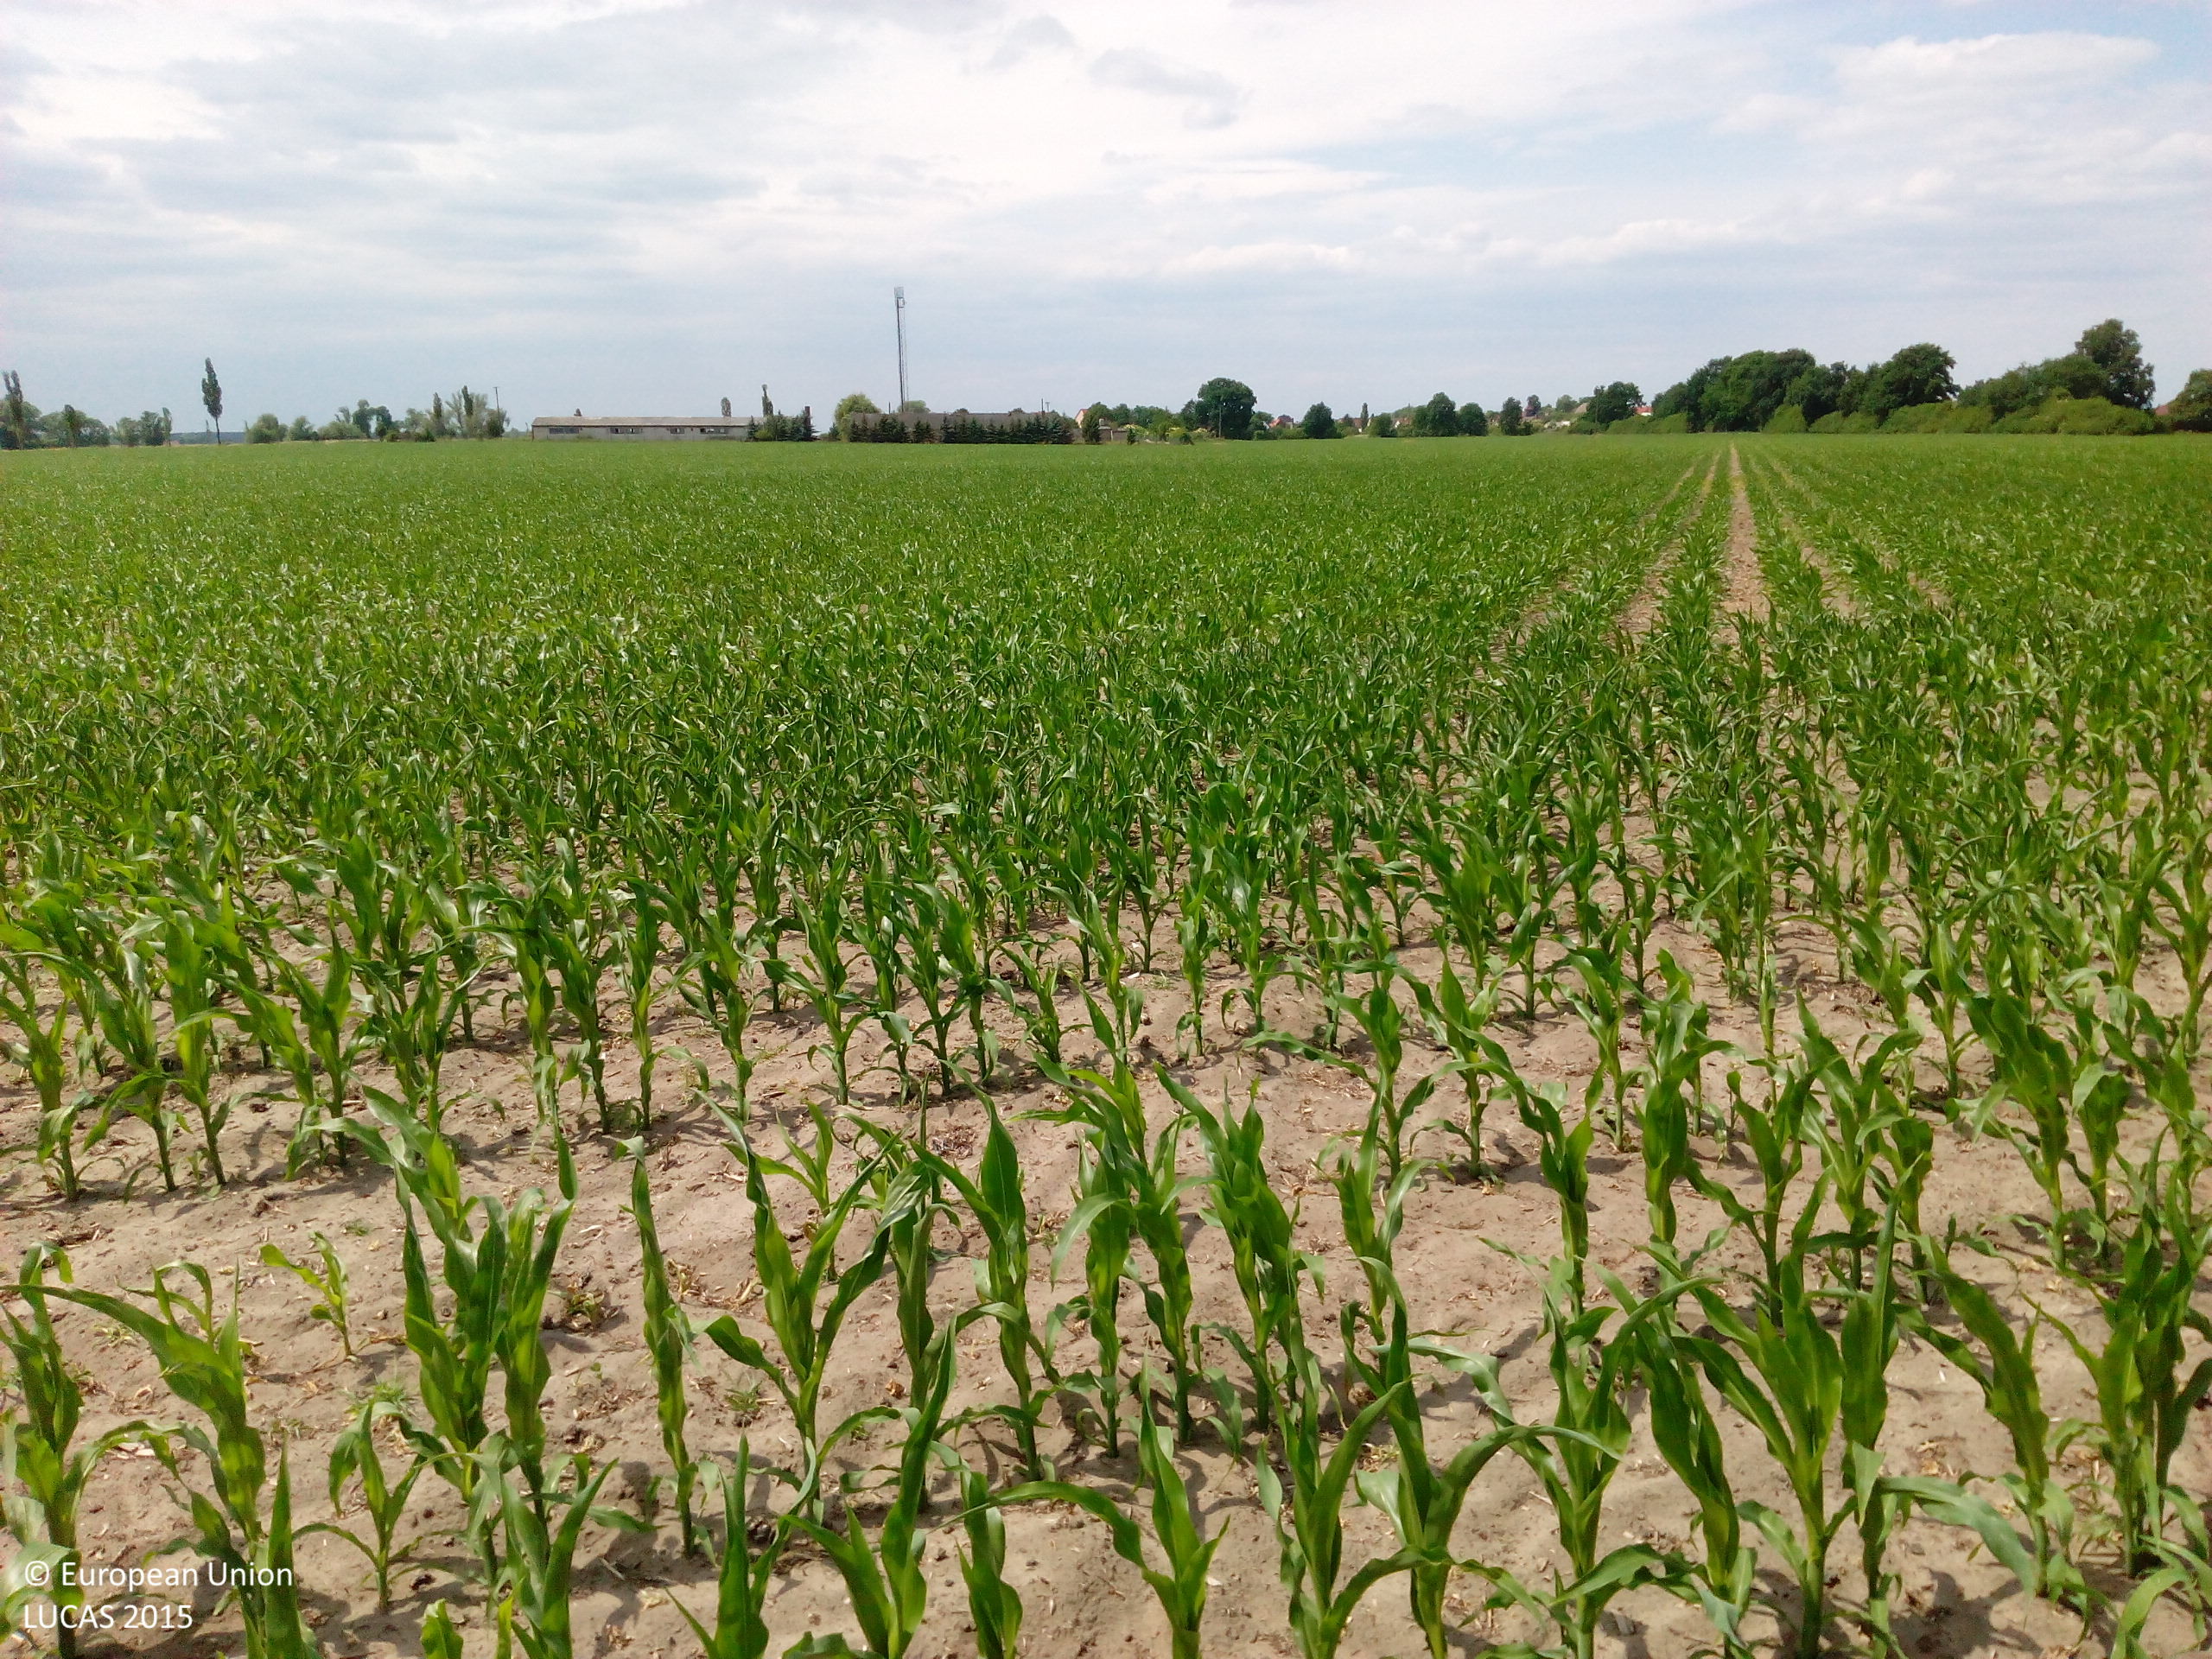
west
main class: Cropland
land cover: Maize
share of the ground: > 75 %
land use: Agriculture (excluding fallow land and kitchen gardens)
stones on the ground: < 10 %
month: June
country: DE
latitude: 51.8282
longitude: 12.5680
